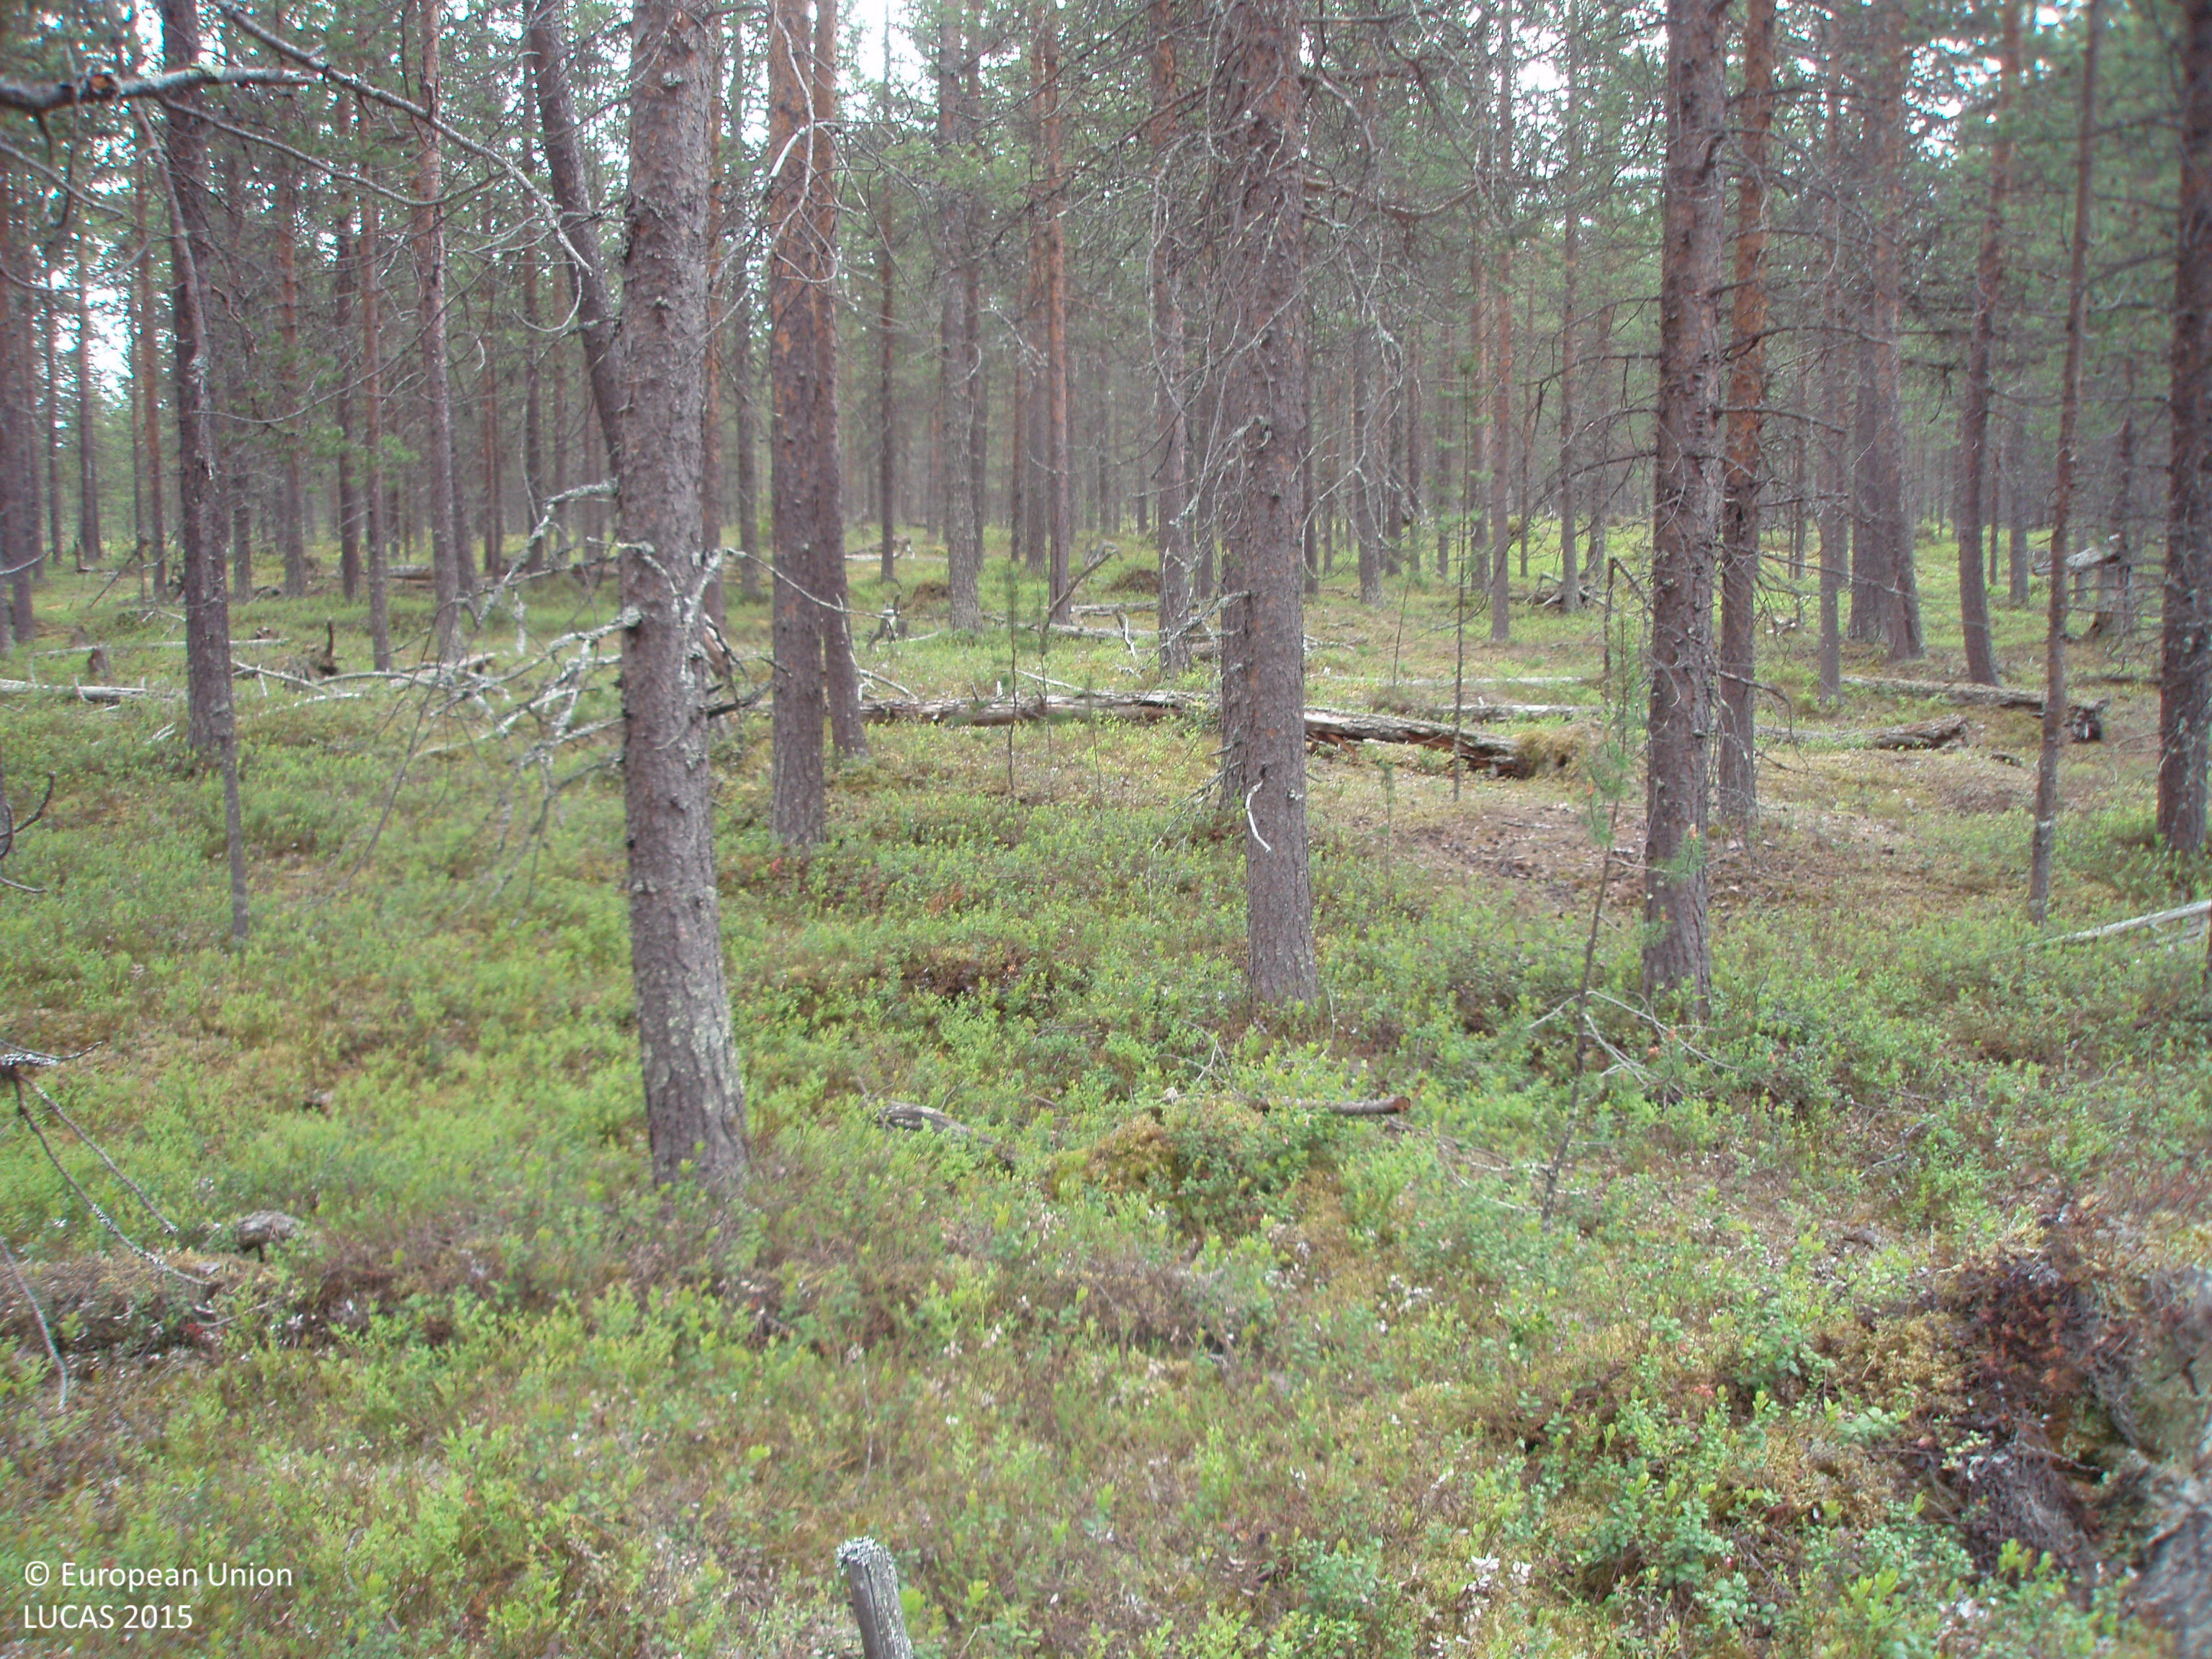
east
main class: Woodland
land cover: Pine dominated coniferous woodland
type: boreal forest
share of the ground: > 75 %
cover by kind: coniferous forest trees 75 %, shrubs 25 %
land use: Forestry
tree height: > 5 m
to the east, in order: Pine dominated coniferous woodland
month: July
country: FI
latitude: 67.7353
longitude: 28.9906
